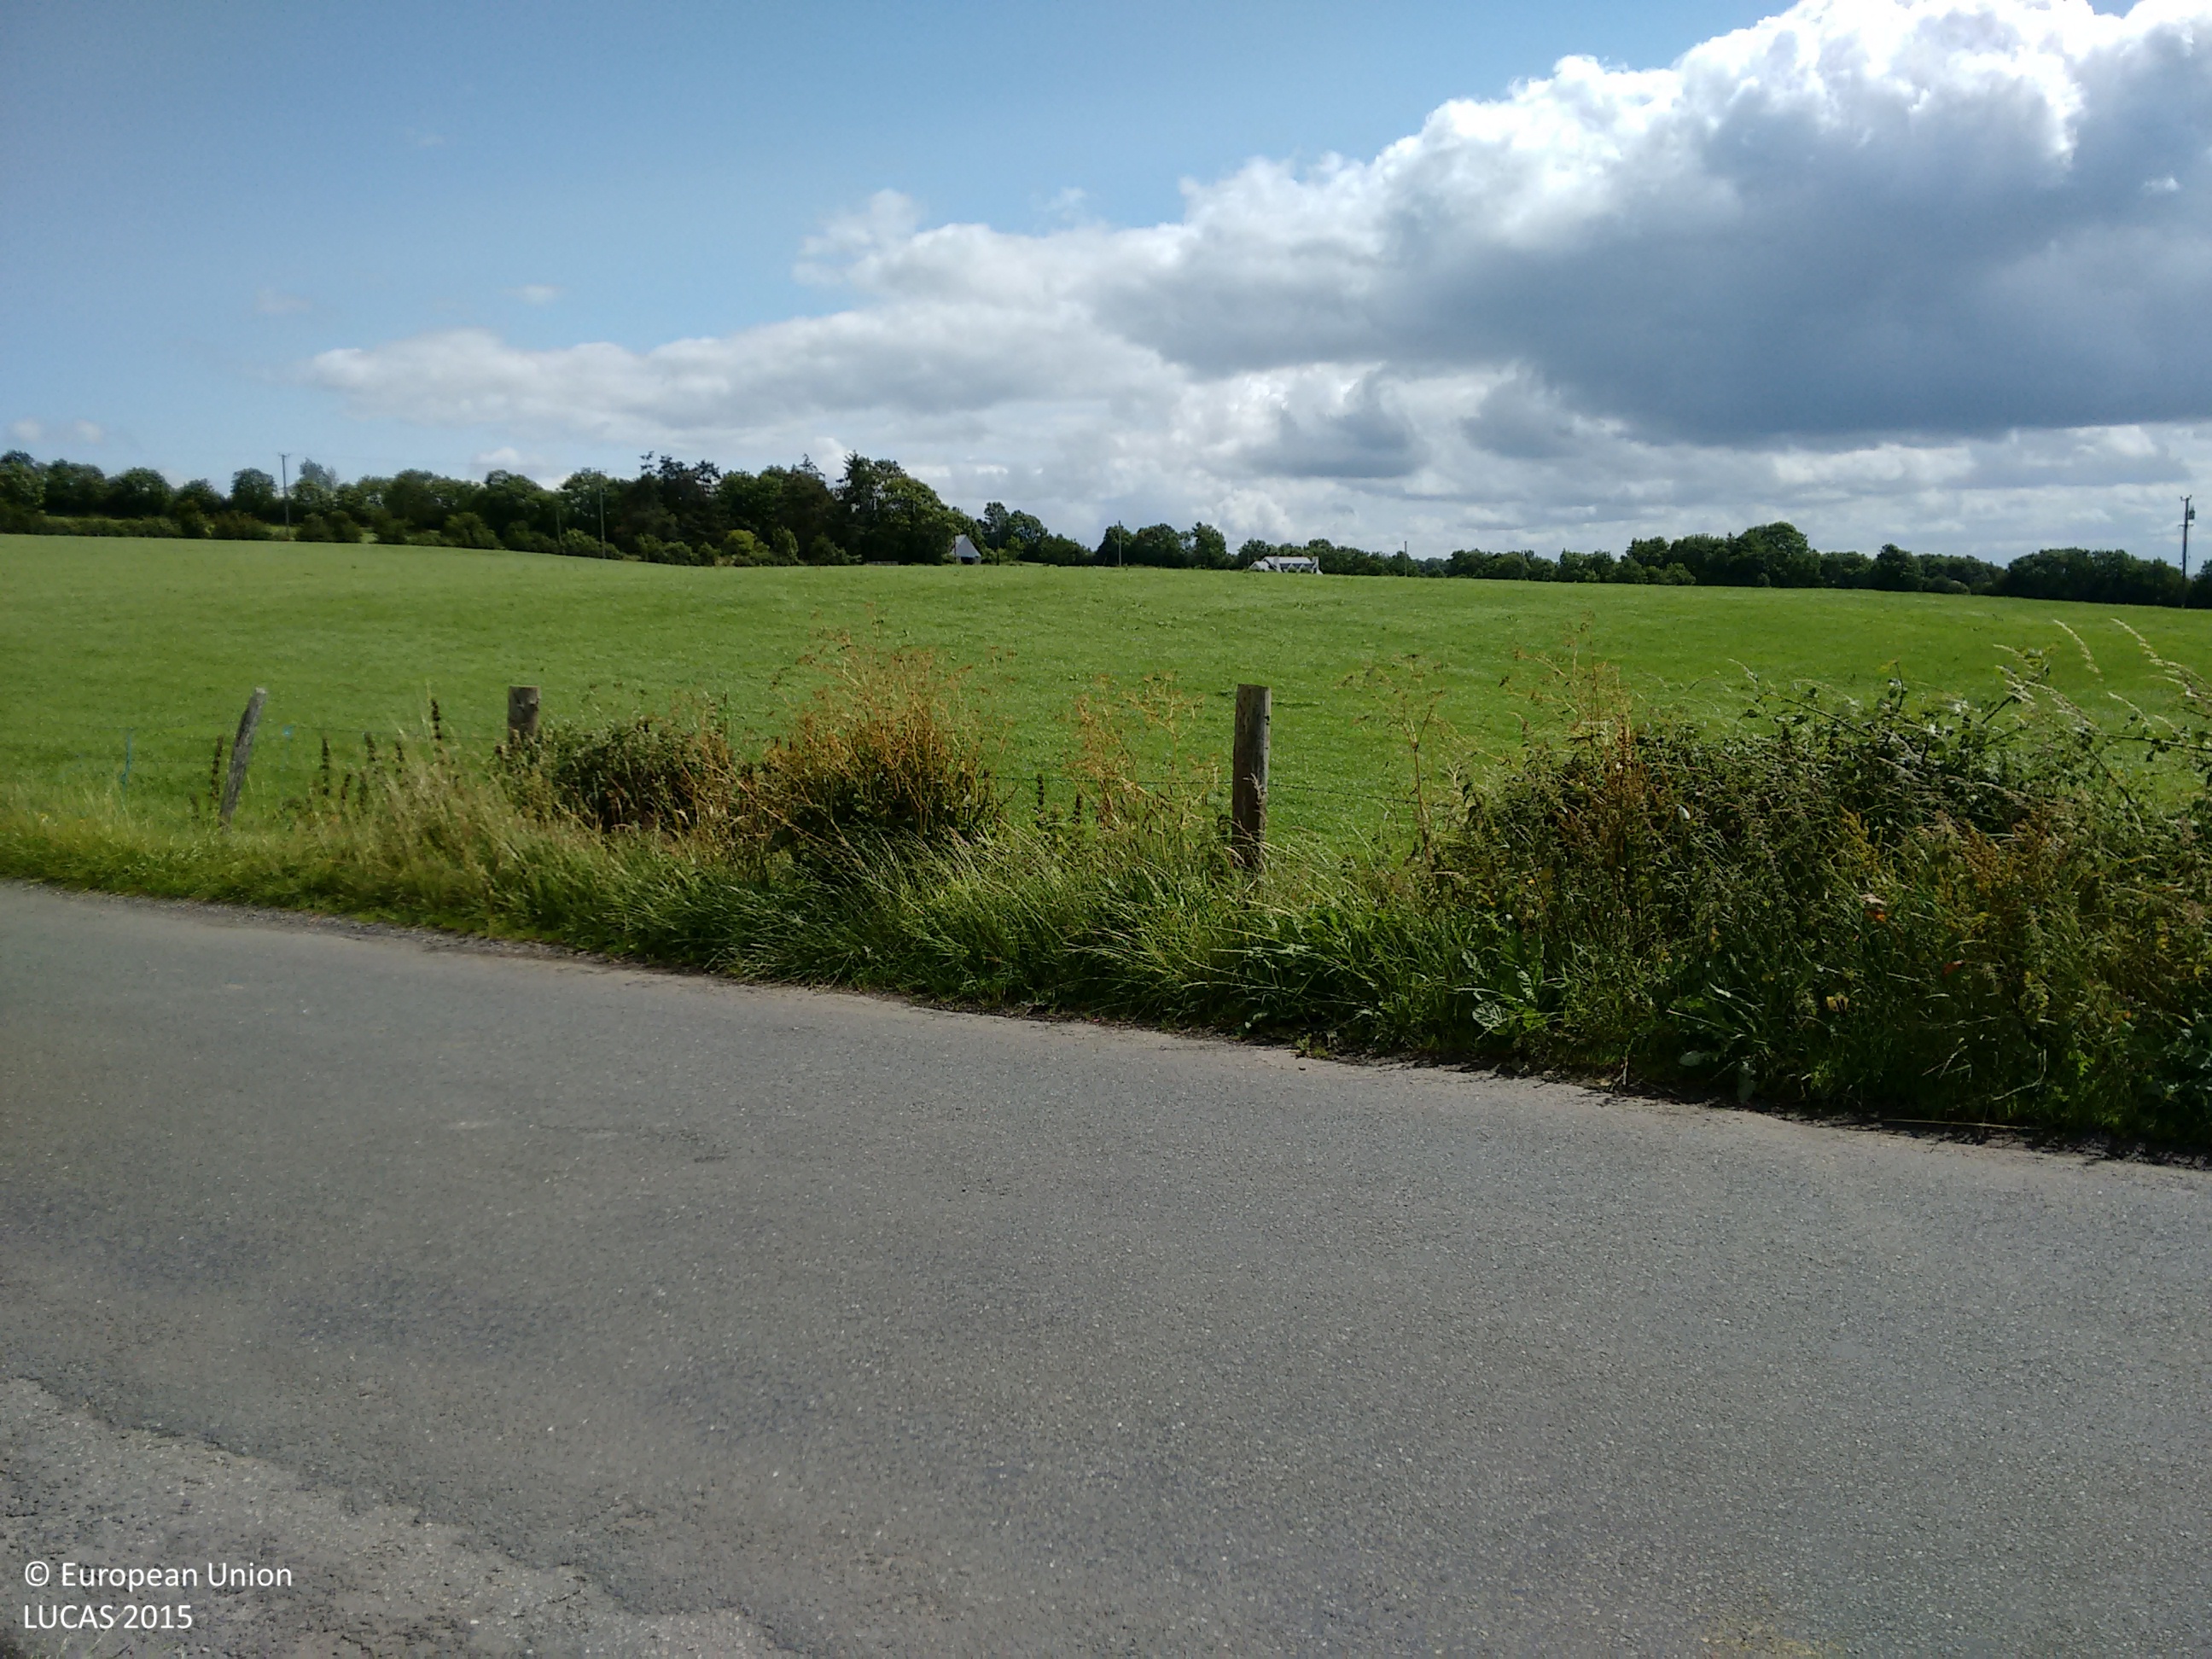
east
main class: Grassland
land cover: Grassland without tree/shrub cover
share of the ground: > 75 %
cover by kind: herbaceous plants 100 %
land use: Agriculture (excluding fallow land and kitchen gardens)
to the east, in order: Grassland without tree/shrub cover; Abandoned hedges; Fences; Electric lines; Grass margins; Paved roads, cycling and walking lanes; Grass margins; Abandoned hedges; Fences; Grassland without tree/shrub cover; Fences; Abandoned hedges; Electric lines; Paved roads, cycling and walking lanes; Grass margins; Fences; Grassland without tree/shrub cover
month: July
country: IE
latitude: 52.7646
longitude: -7.4522
